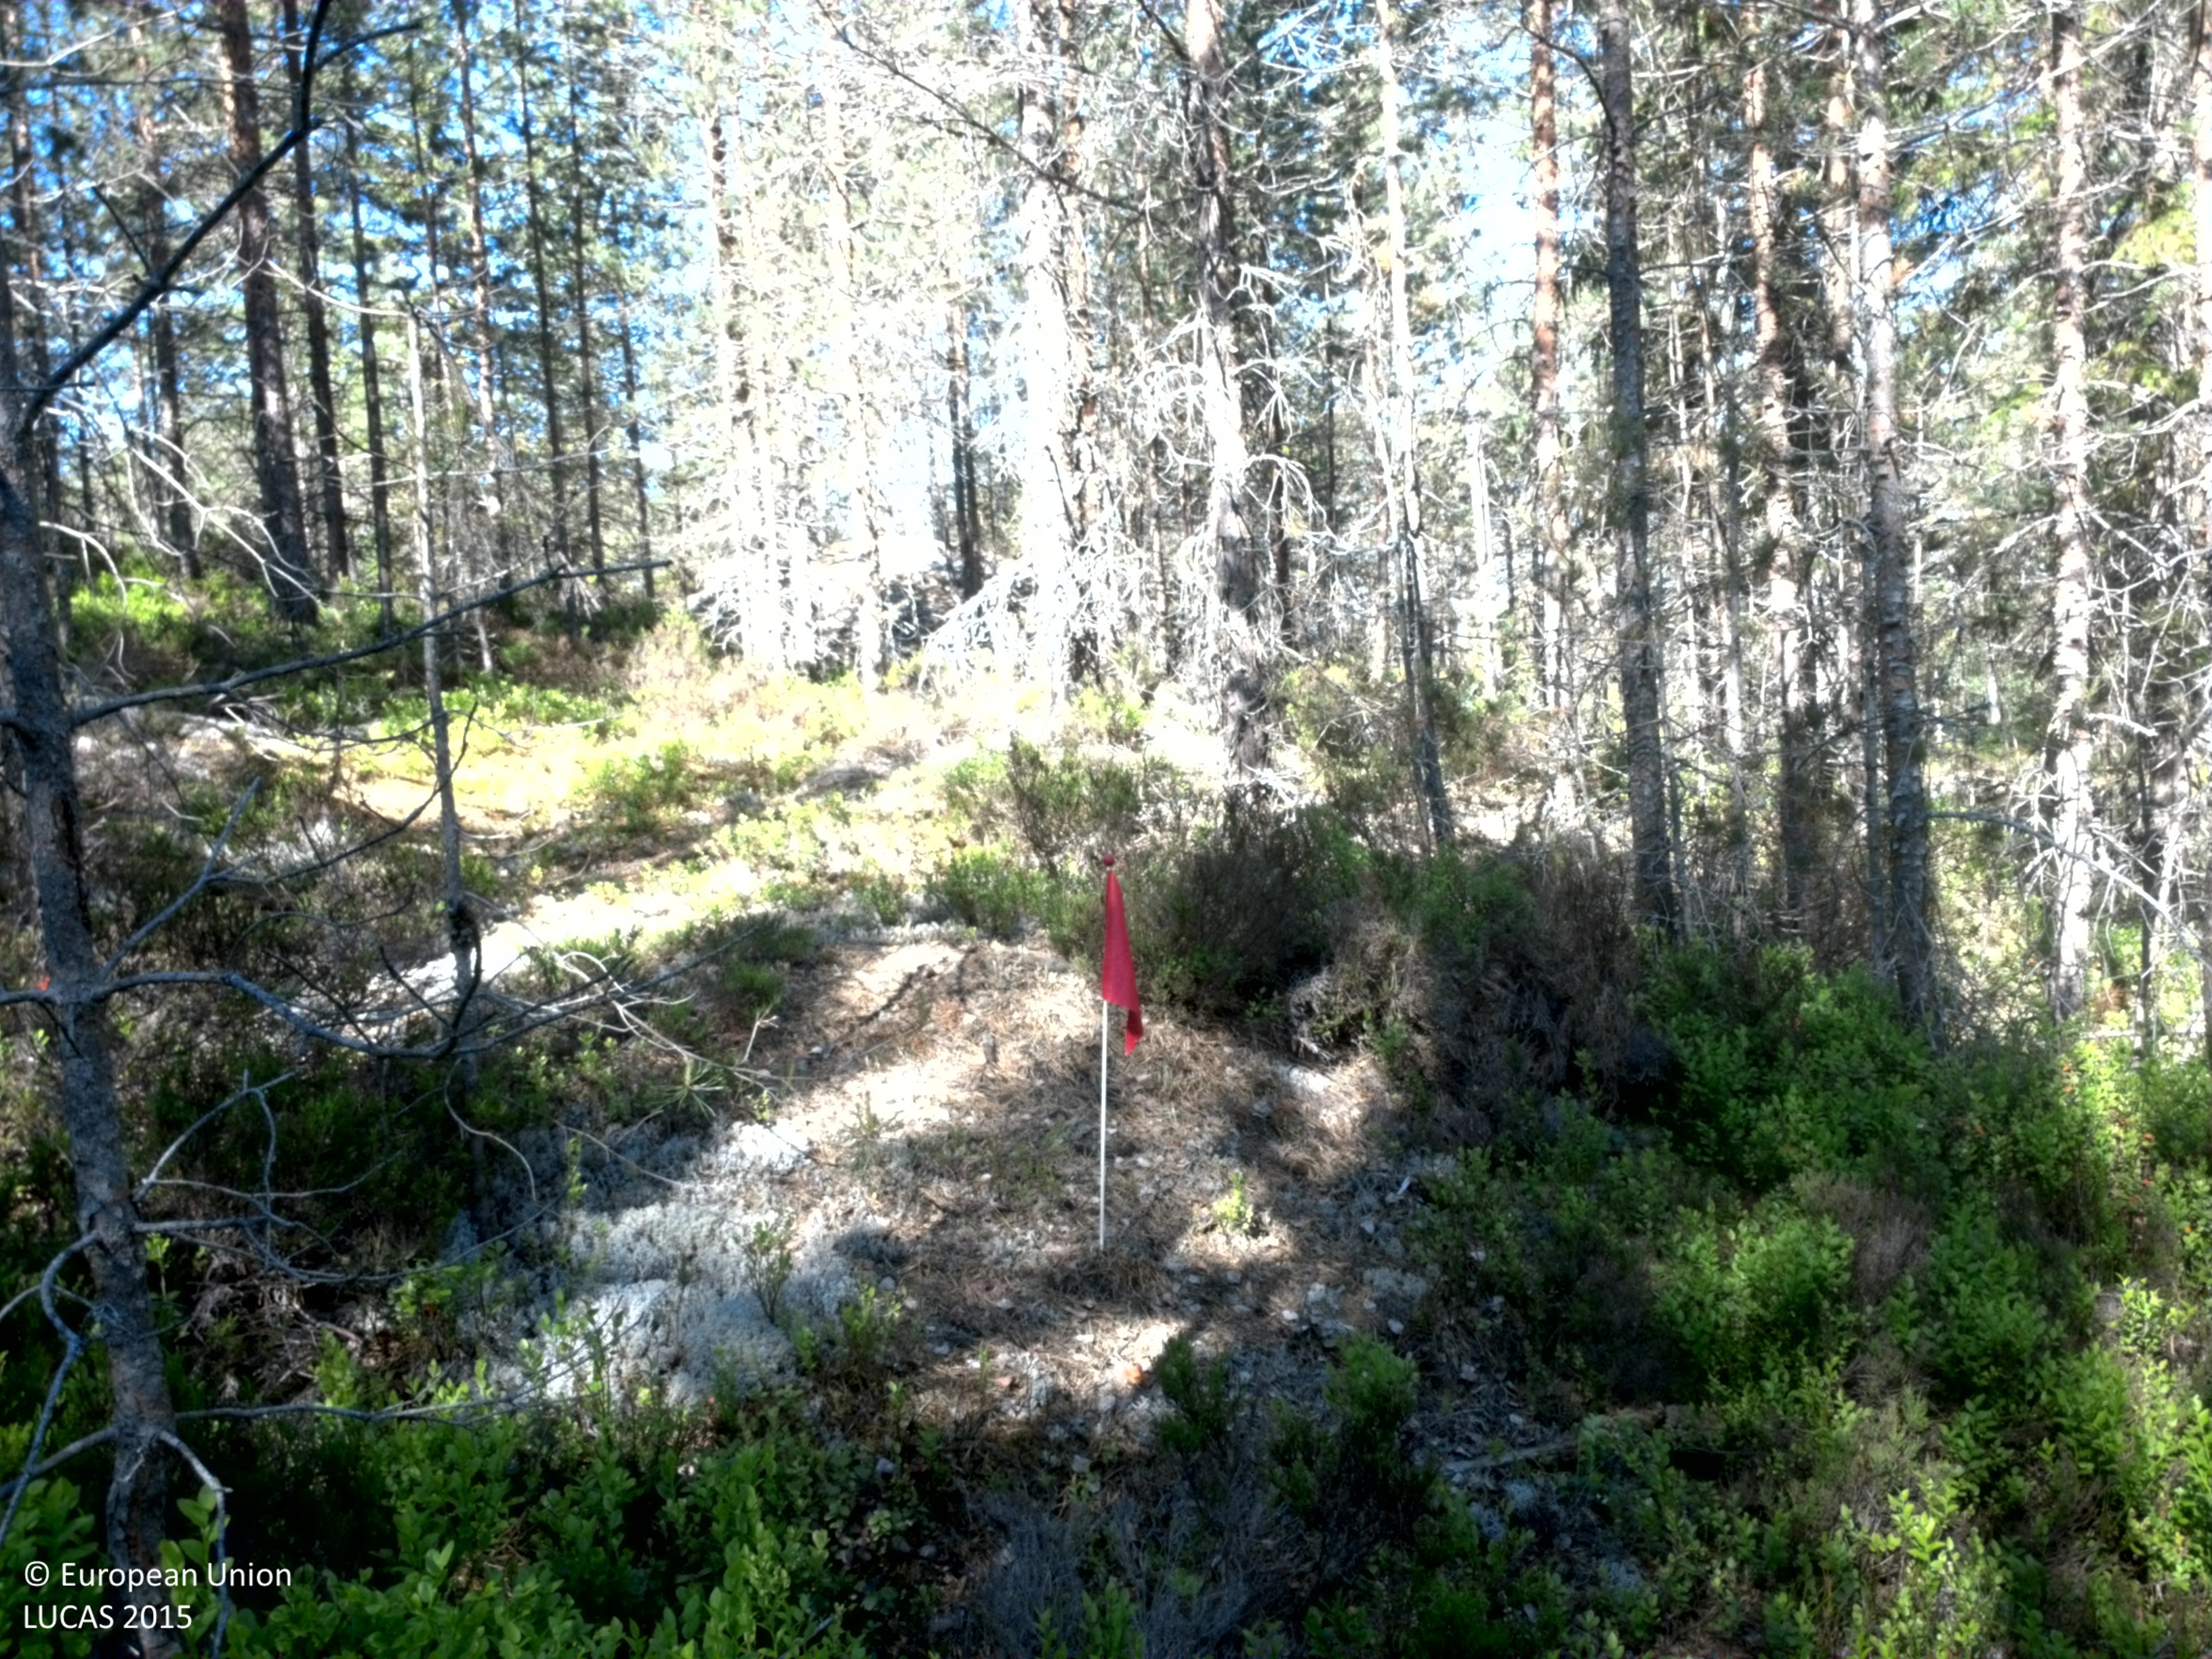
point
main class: Woodland
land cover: Pine dominated coniferous woodland
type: boreal forest
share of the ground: 25 - 50 %
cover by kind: coniferous forest trees 45 %, shrubs 25 %, lichens and mosses 20 %, broadleaved forest trees 5 %, herbaceous plants 5 %
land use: Forestry
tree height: > 5 m
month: July
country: SE
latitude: 59.8072
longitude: 11.9376
